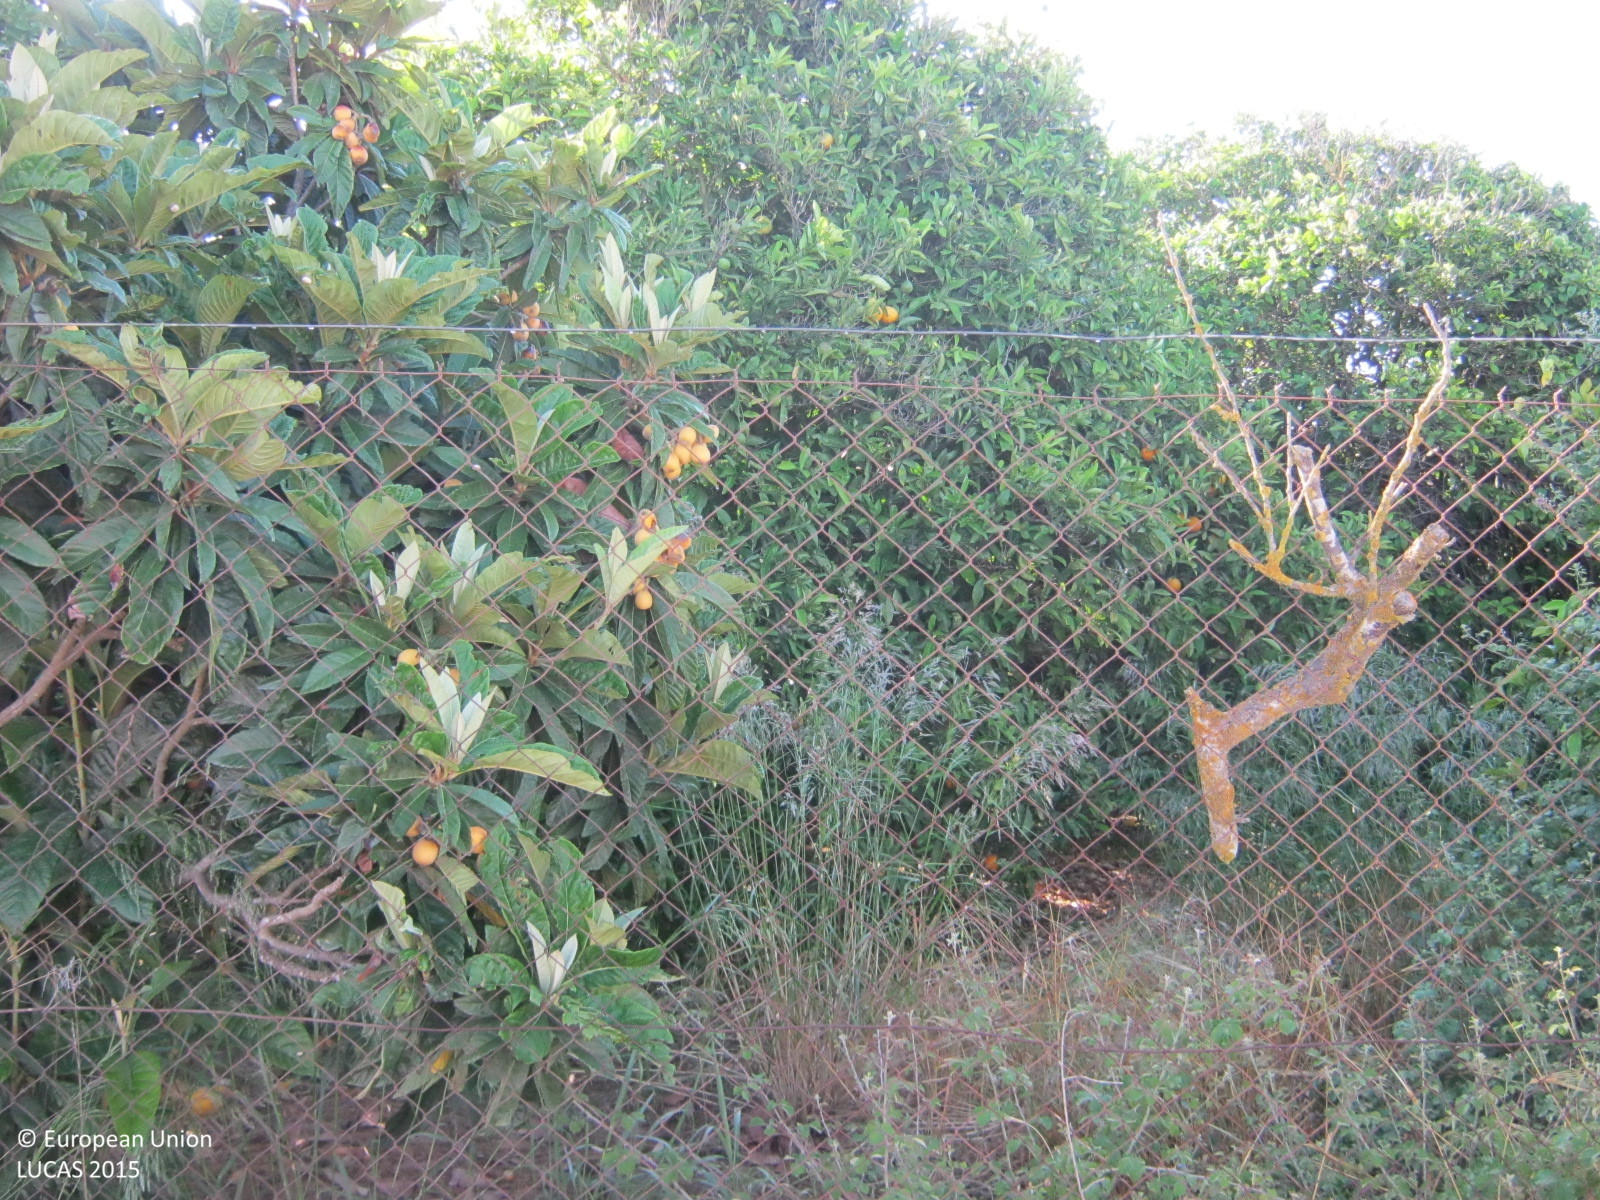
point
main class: Cropland
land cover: Permanent crops (only in case pi)
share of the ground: > 75 %
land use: Agriculture (excluding fallow land and kitchen gardens)
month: May
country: GR
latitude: 35.0721
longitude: 24.8000
